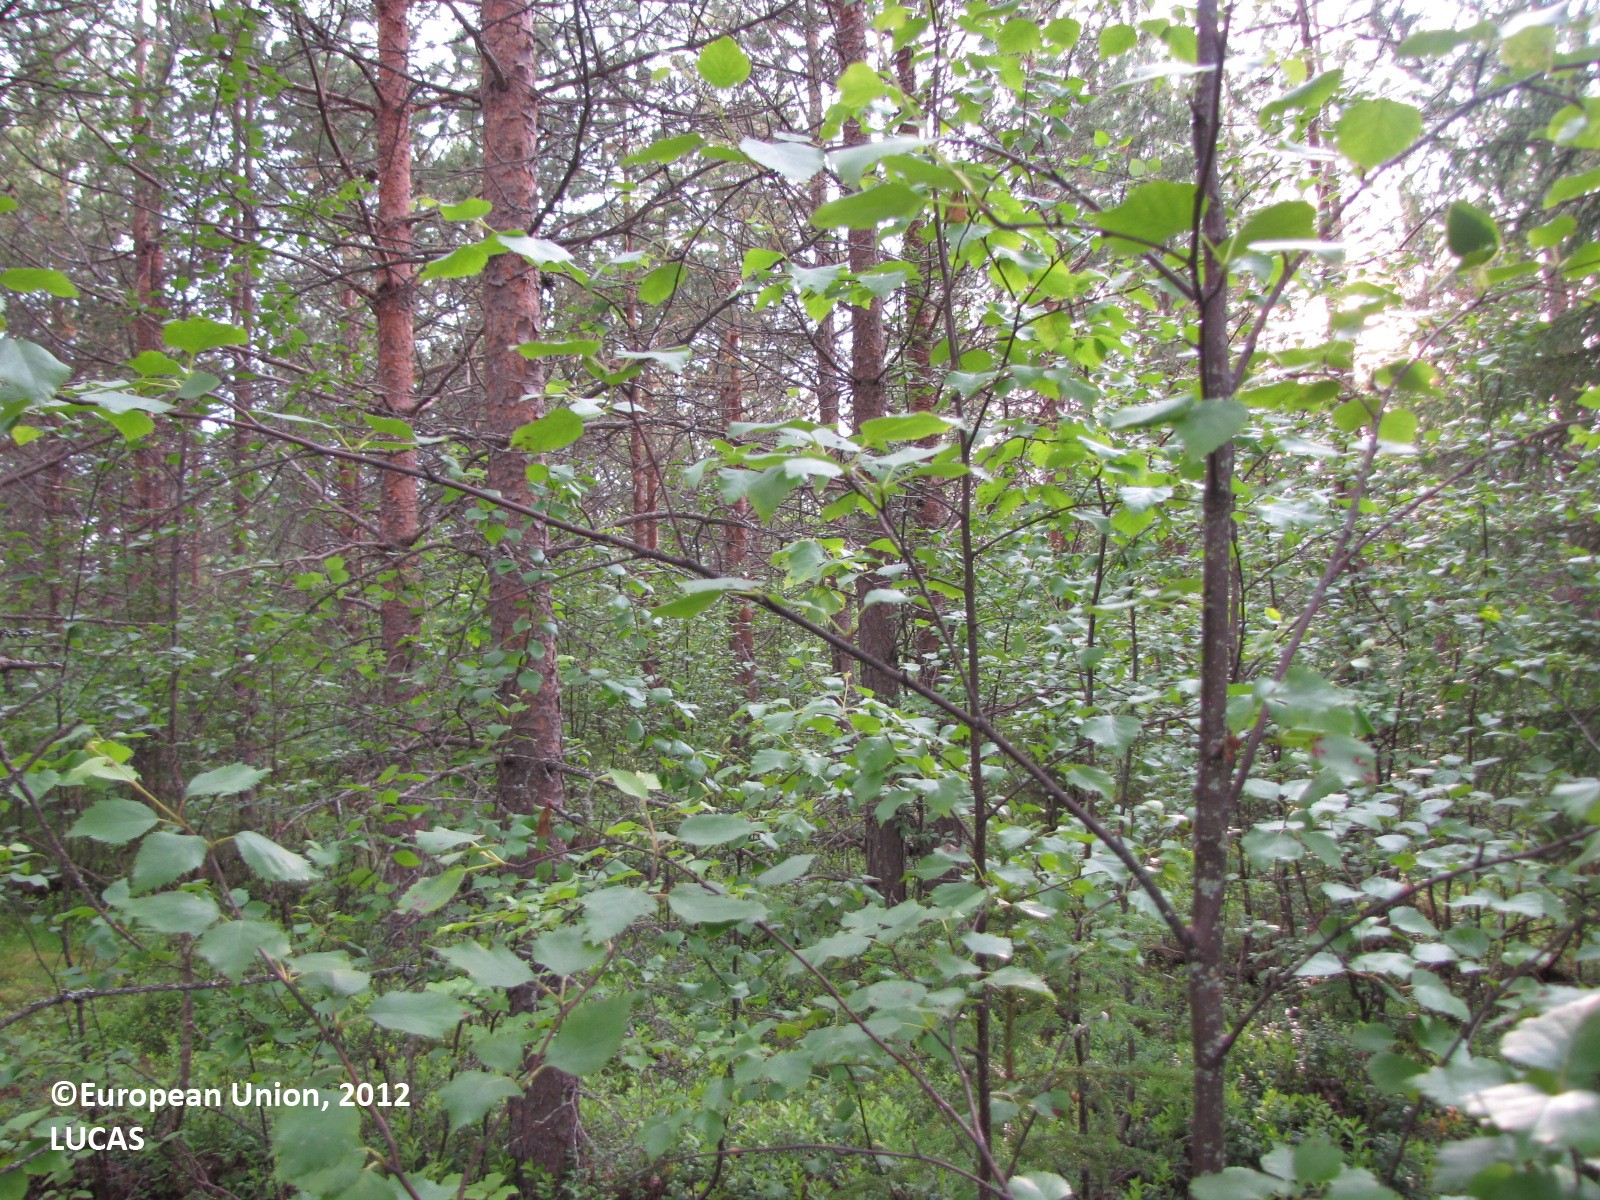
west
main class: Woodland
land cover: Pine dominated mixed woodland
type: boreal forest
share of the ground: 50 - 75 %
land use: Forestry
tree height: > 5 m
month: July
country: FI
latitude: 66.3900
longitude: 25.0705
